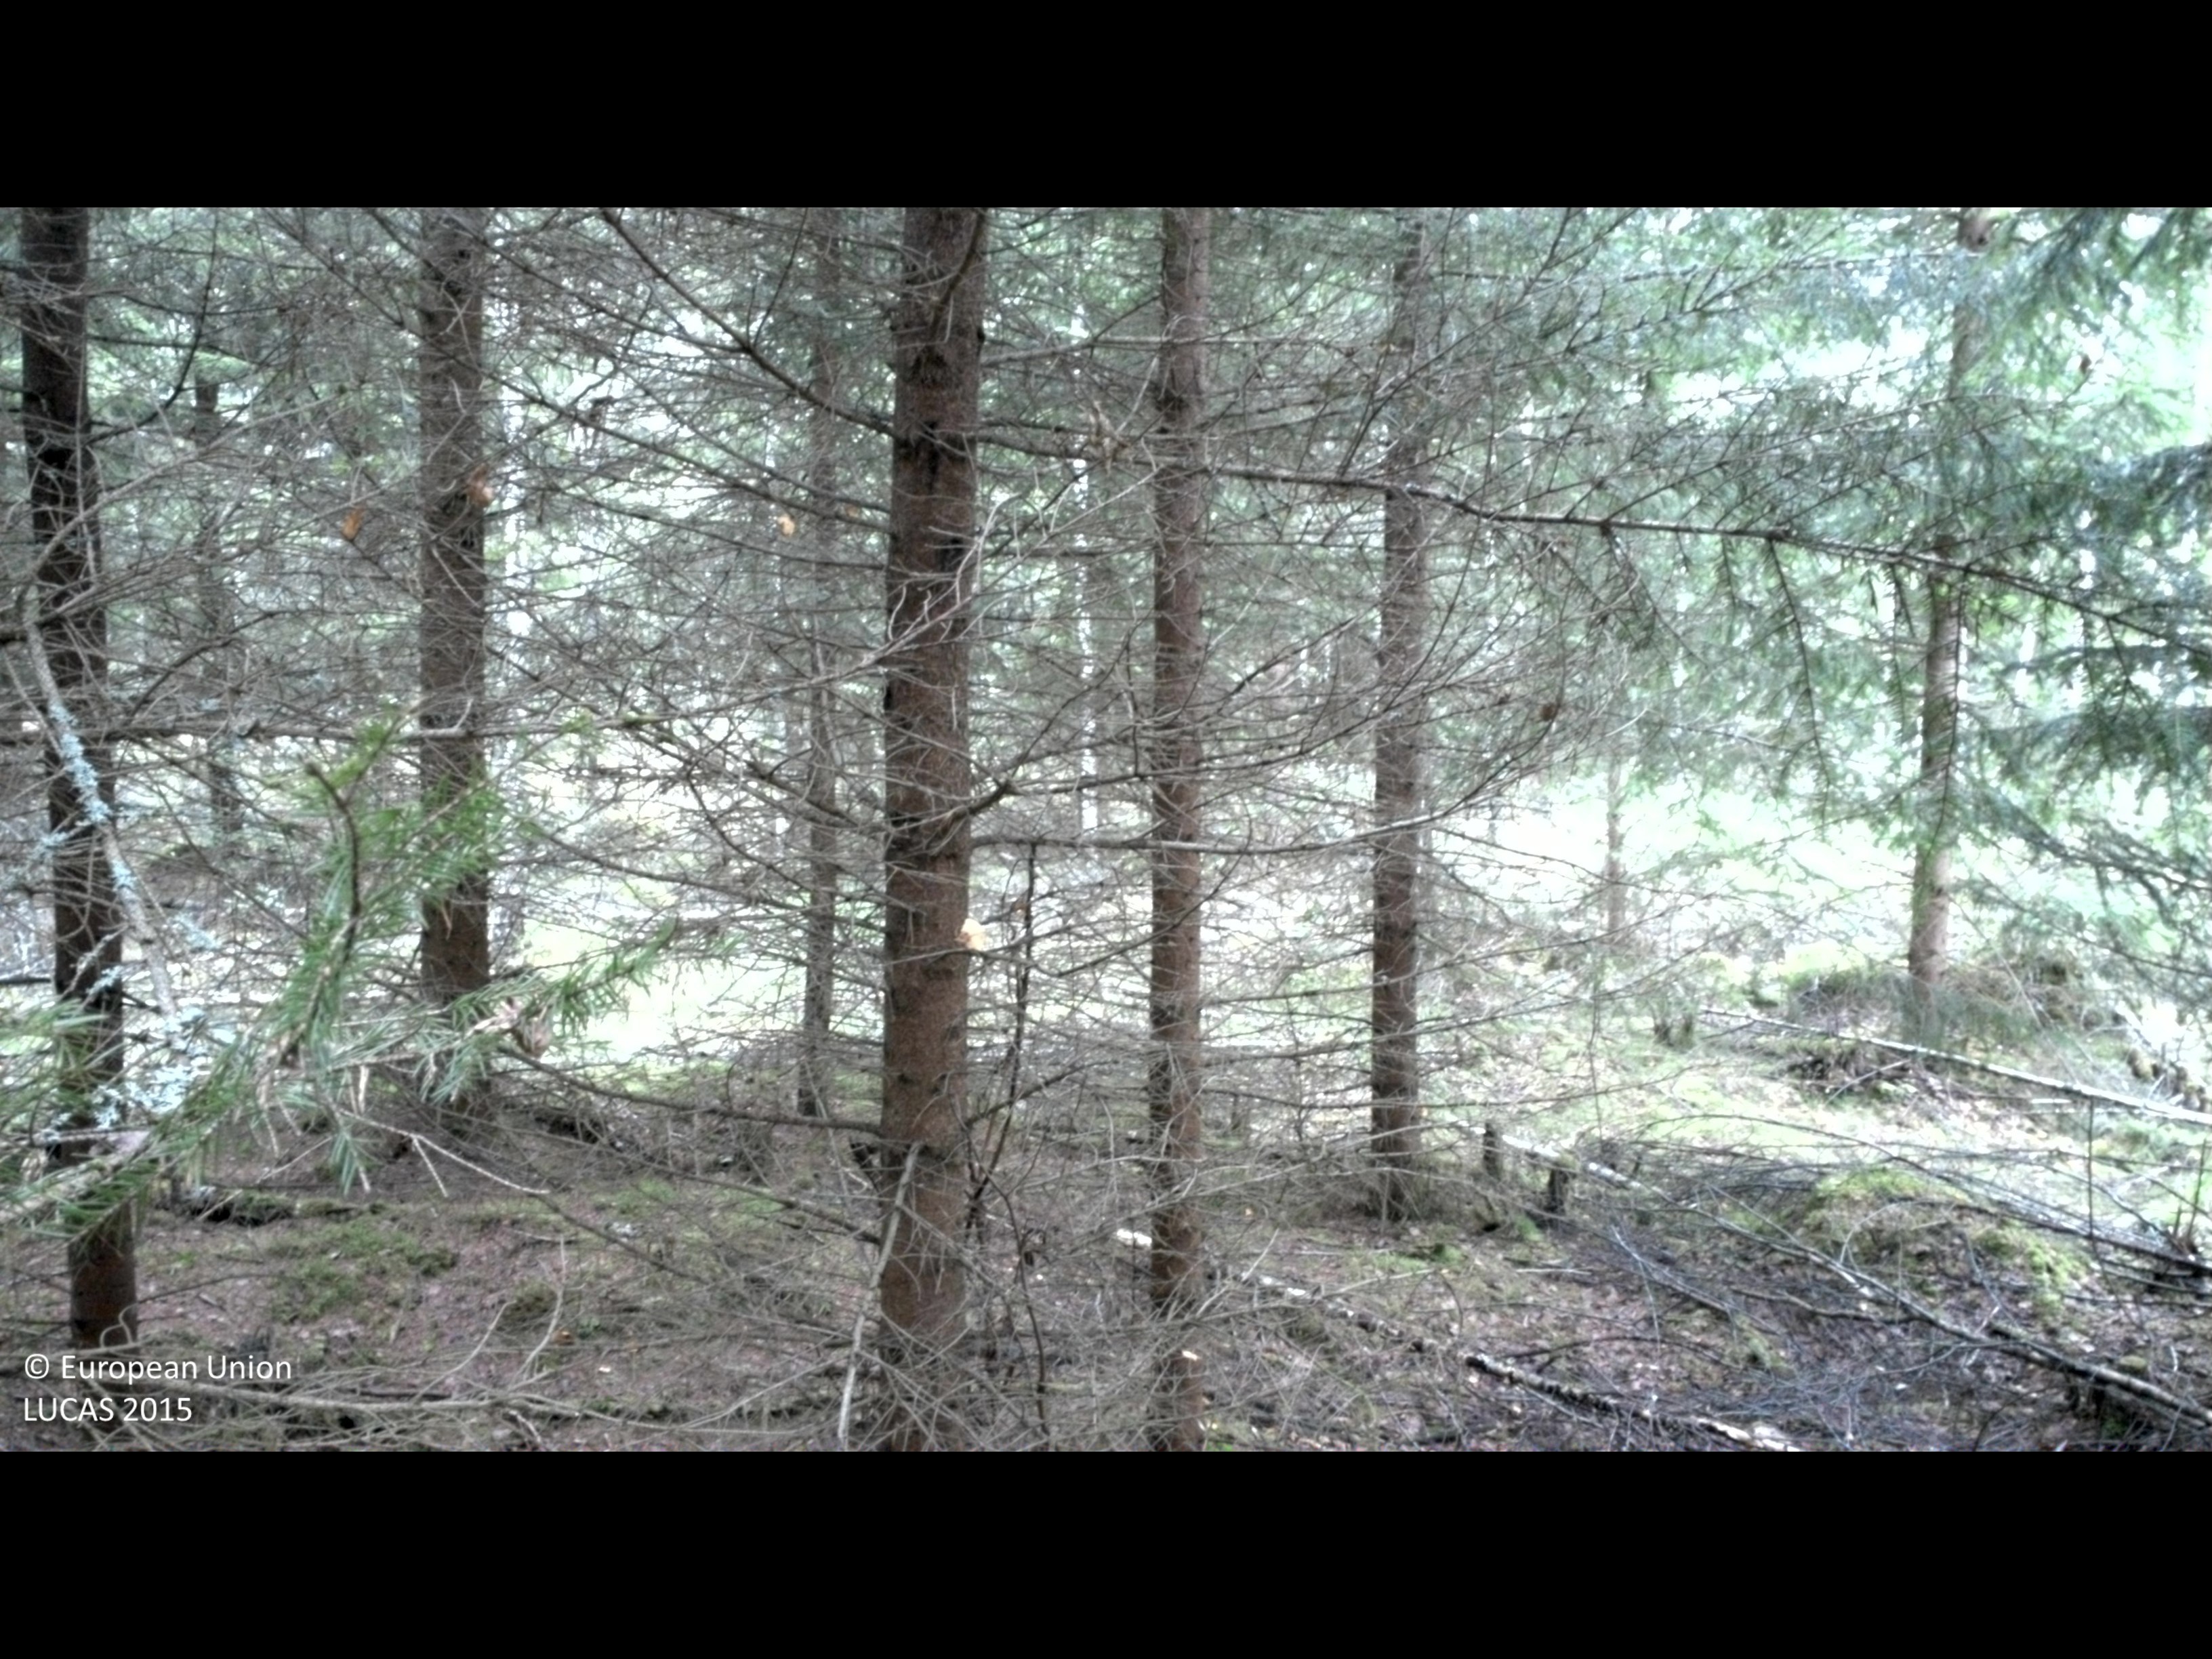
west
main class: Woodland
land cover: Spruce dominated coniferous woodland
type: boreal forest
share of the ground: > 75 %
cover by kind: coniferous forest trees 60 %, broadleaved forest trees 15 %, lichens and mosses 15 %, shrubs 10 %
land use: Forestry
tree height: > 5 m
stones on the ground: 25 - 50 %
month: July
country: SE
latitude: 56.8501
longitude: 13.8498
